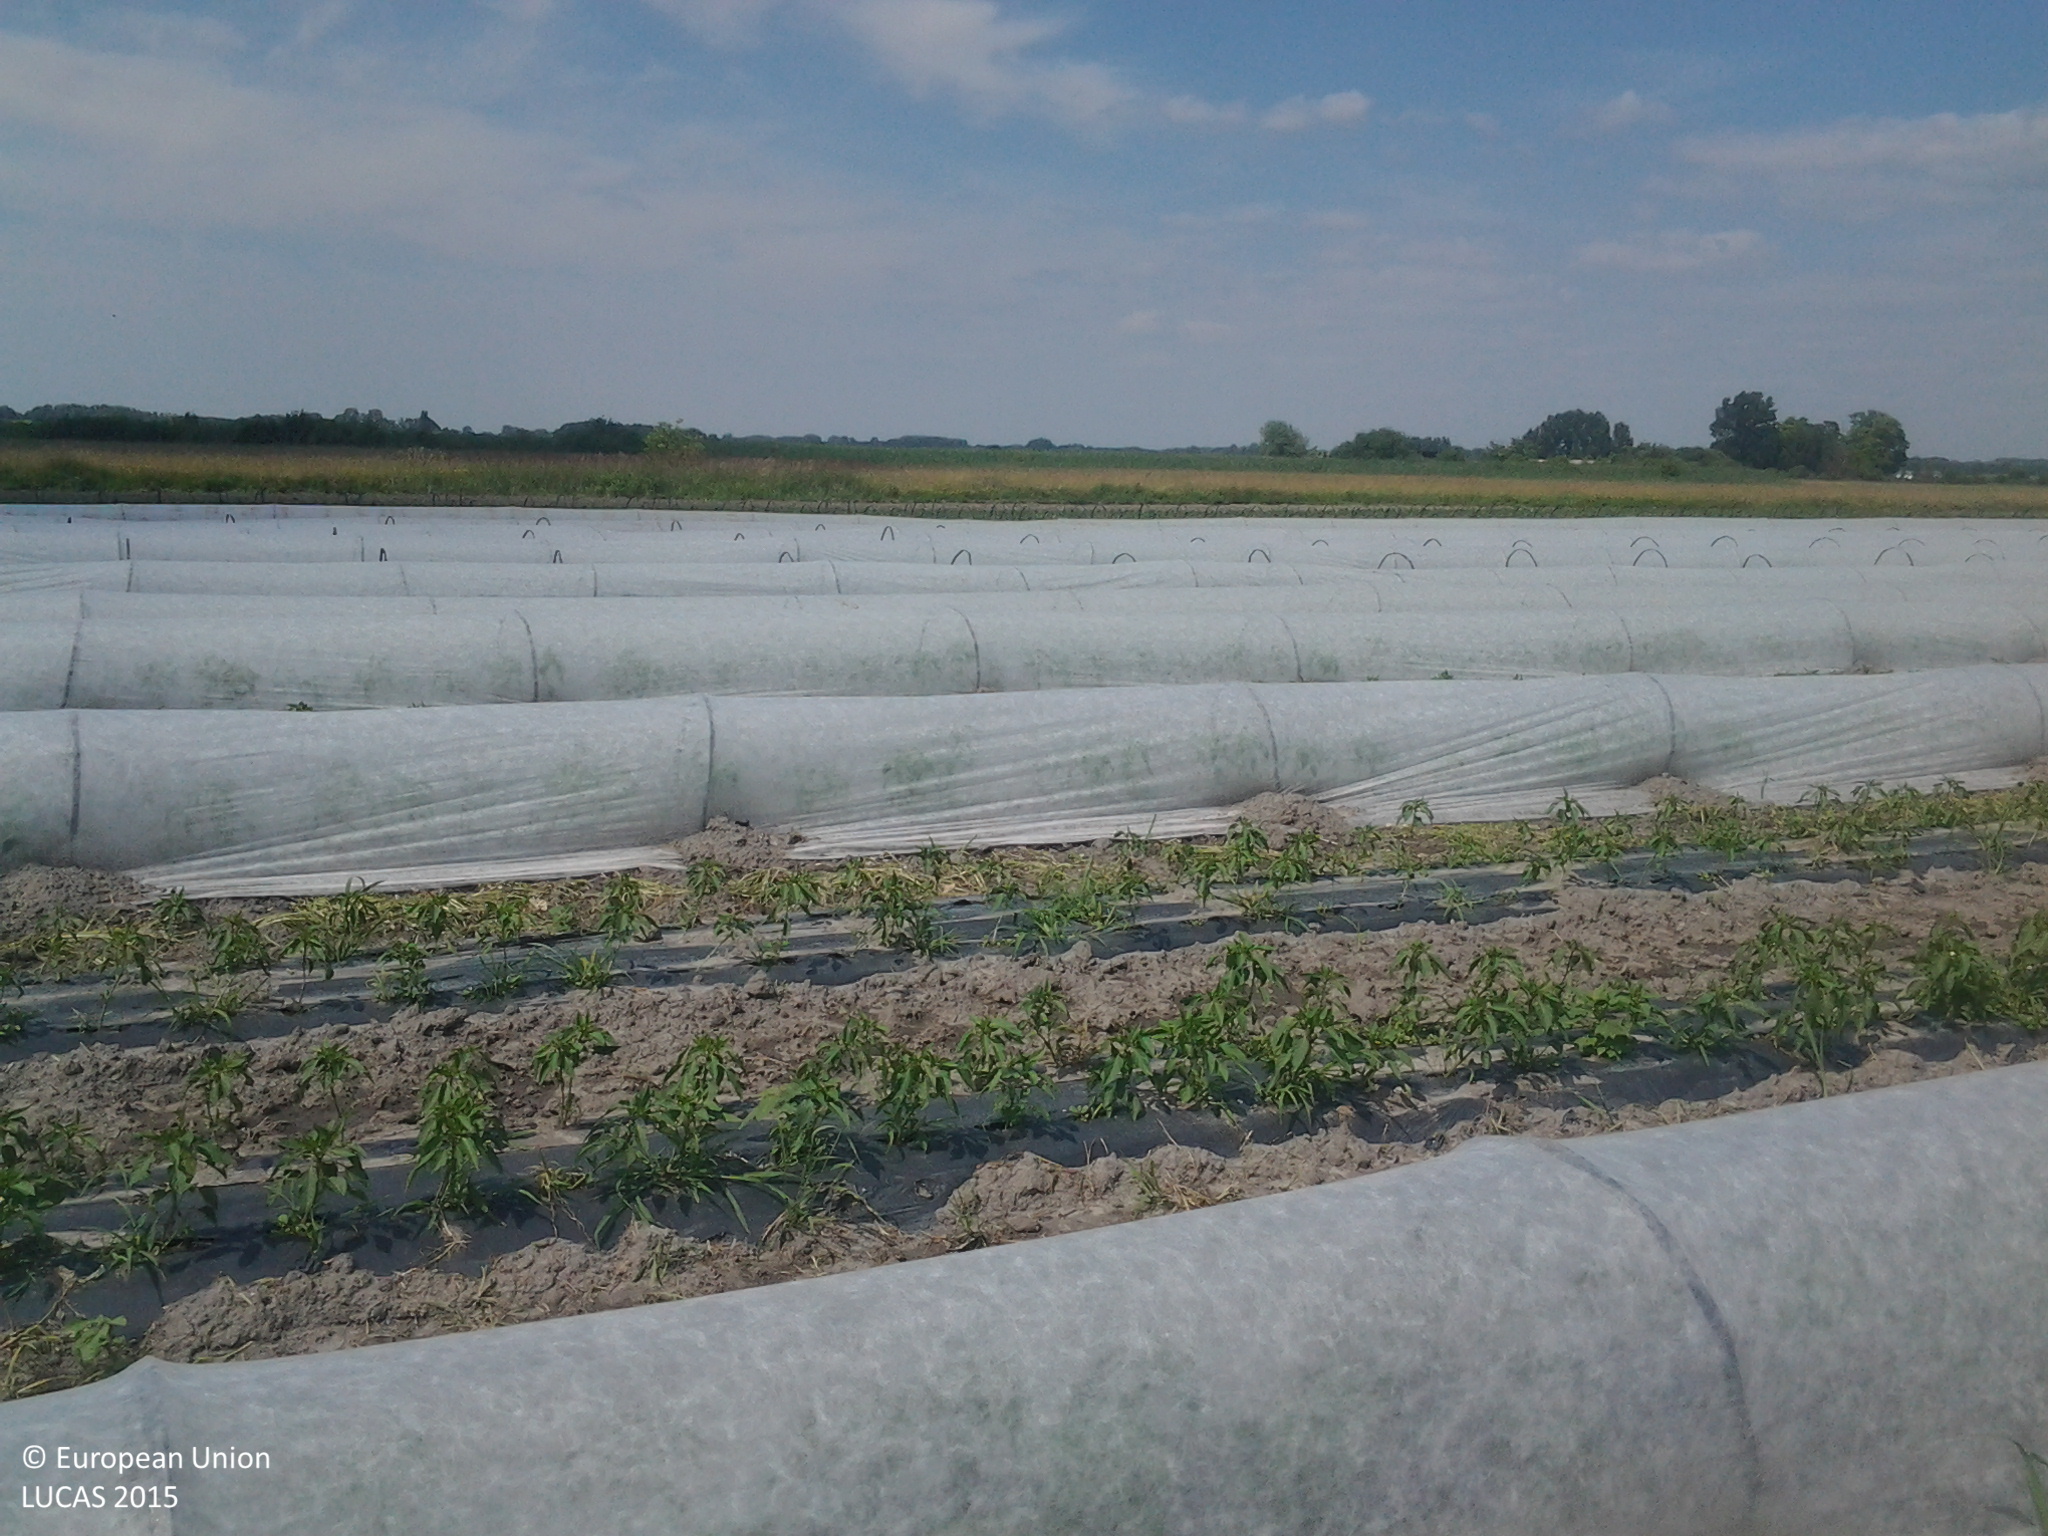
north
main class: Cropland
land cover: Other fresh vegetables
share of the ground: 50 - 75 %
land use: Agriculture (excluding fallow land and kitchen gardens)
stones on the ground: < 10 %
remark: Tilled/Sowed
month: June
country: HU
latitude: 46.9594
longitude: 19.3086
